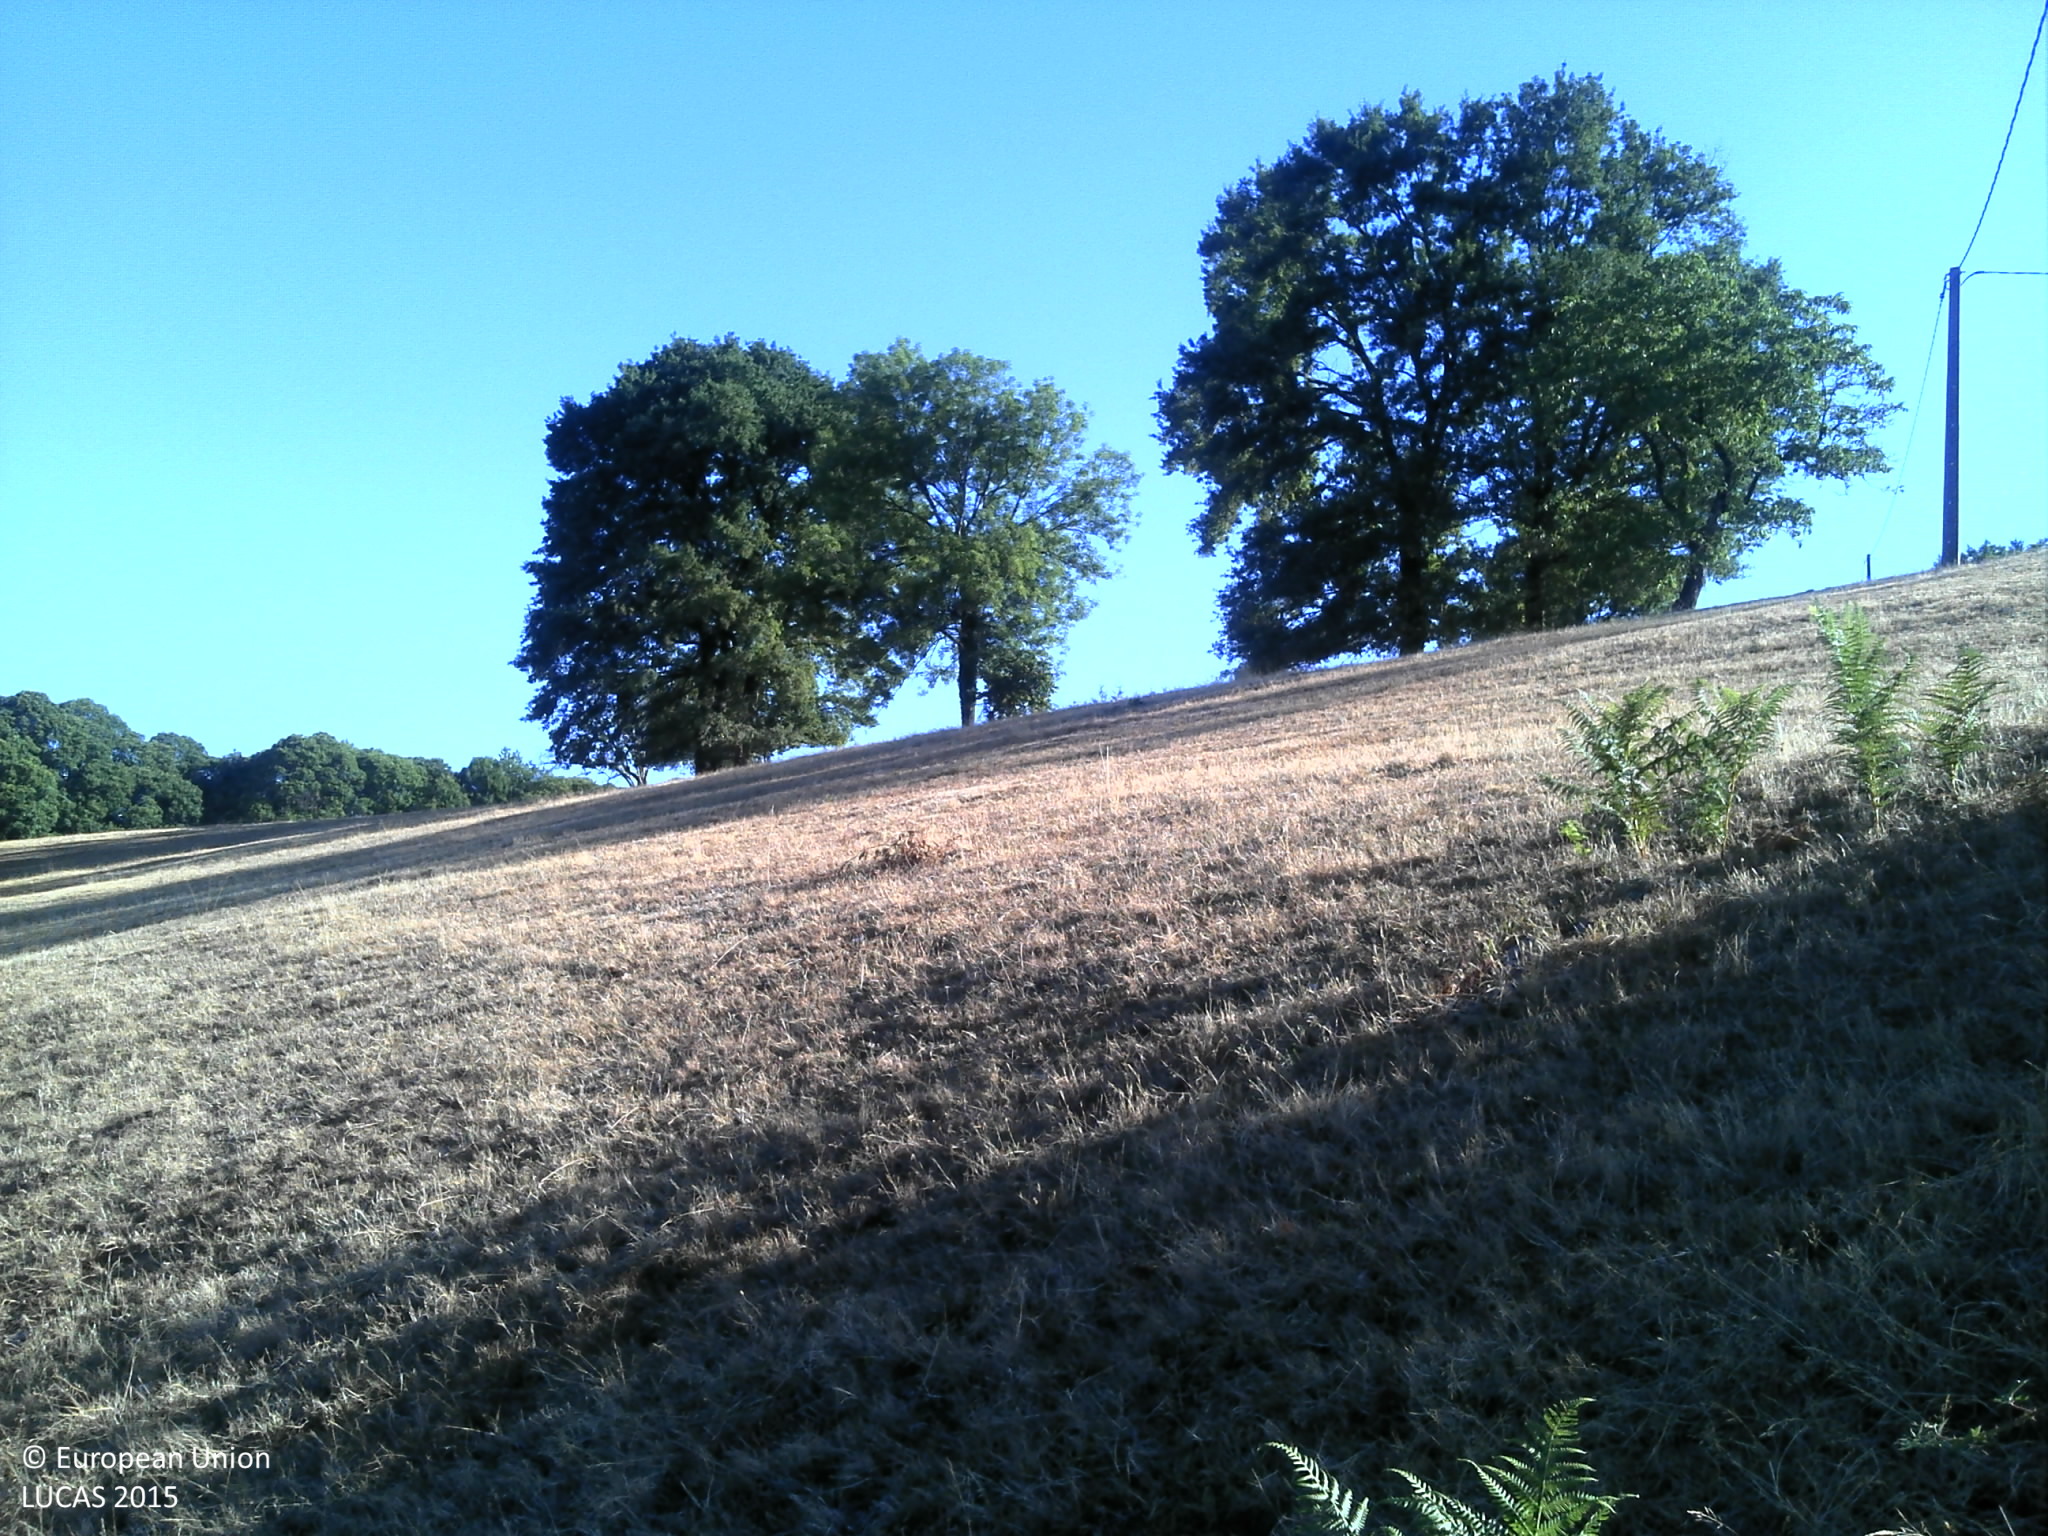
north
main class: Grassland
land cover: Grassland with sparse tree/shrub cover
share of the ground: > 75 %
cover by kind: herbaceous plants 95 %, broadleaved forest trees 5 %
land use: Agriculture (excluding fallow land and kitchen gardens)
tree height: > 5 m
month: July
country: FR
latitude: 45.1085
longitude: 1.7479
